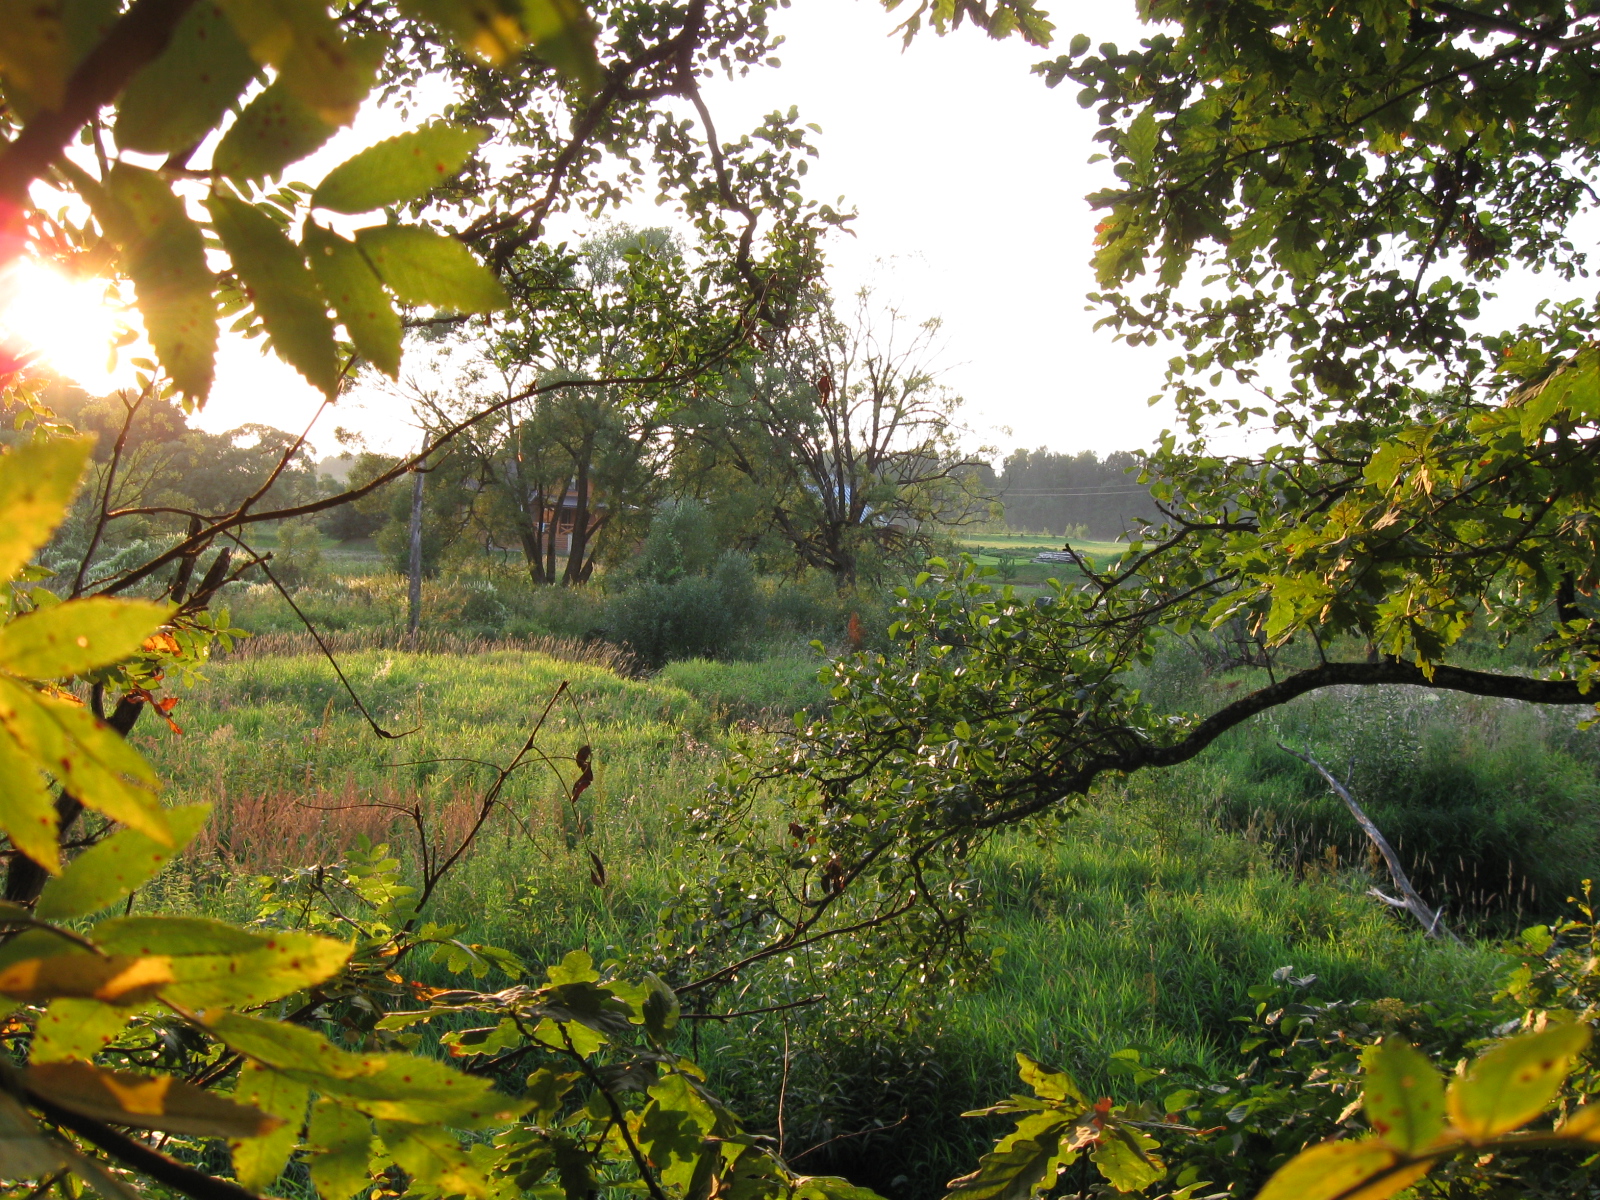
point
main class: Grassland
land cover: Grassland with sparse tree/shrub cover
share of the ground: > 75 %
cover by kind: herbaceous plants 85 %, shrubs 10 %, broadleaved forest trees 5 %
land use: Semi-natural and natural areas not in use
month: August
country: LT
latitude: 54.7027
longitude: 23.5049
